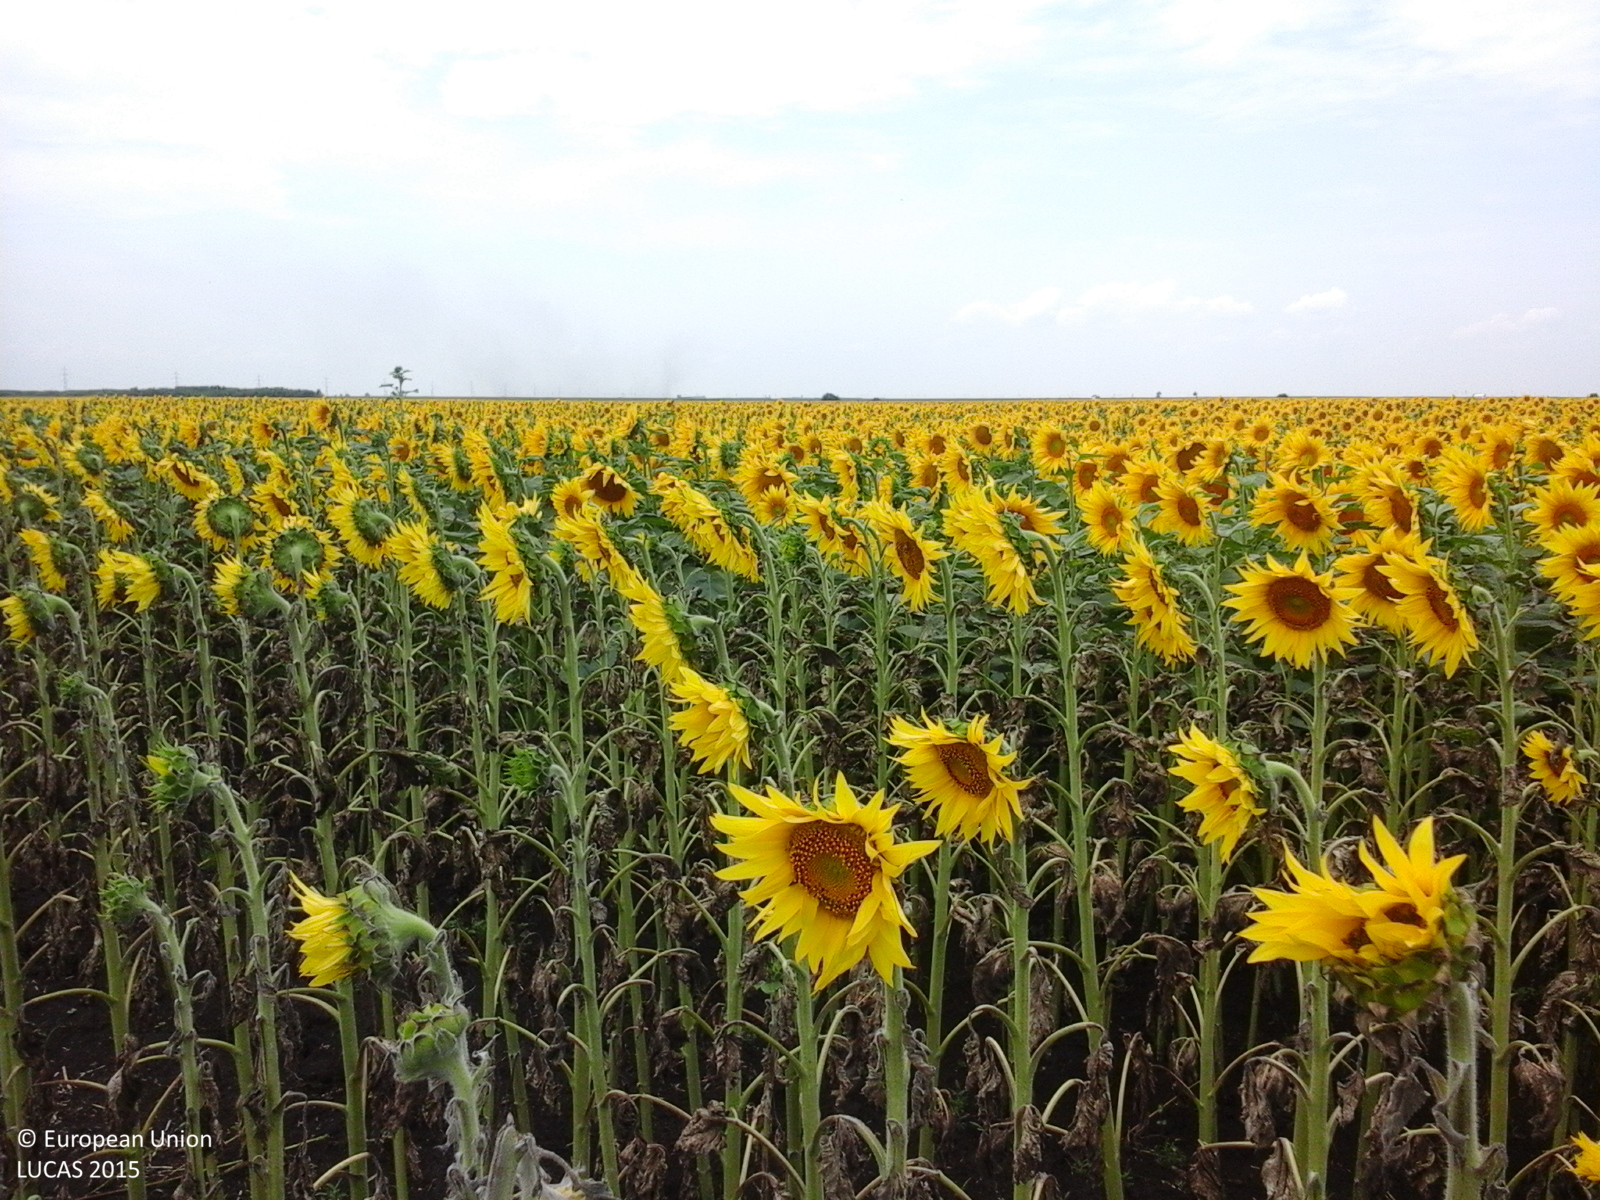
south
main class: Cropland
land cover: Sunflower
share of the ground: > 75 %
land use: Agriculture (excluding fallow land and kitchen gardens)
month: July
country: RO
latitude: 44.0007
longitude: 25.8710
